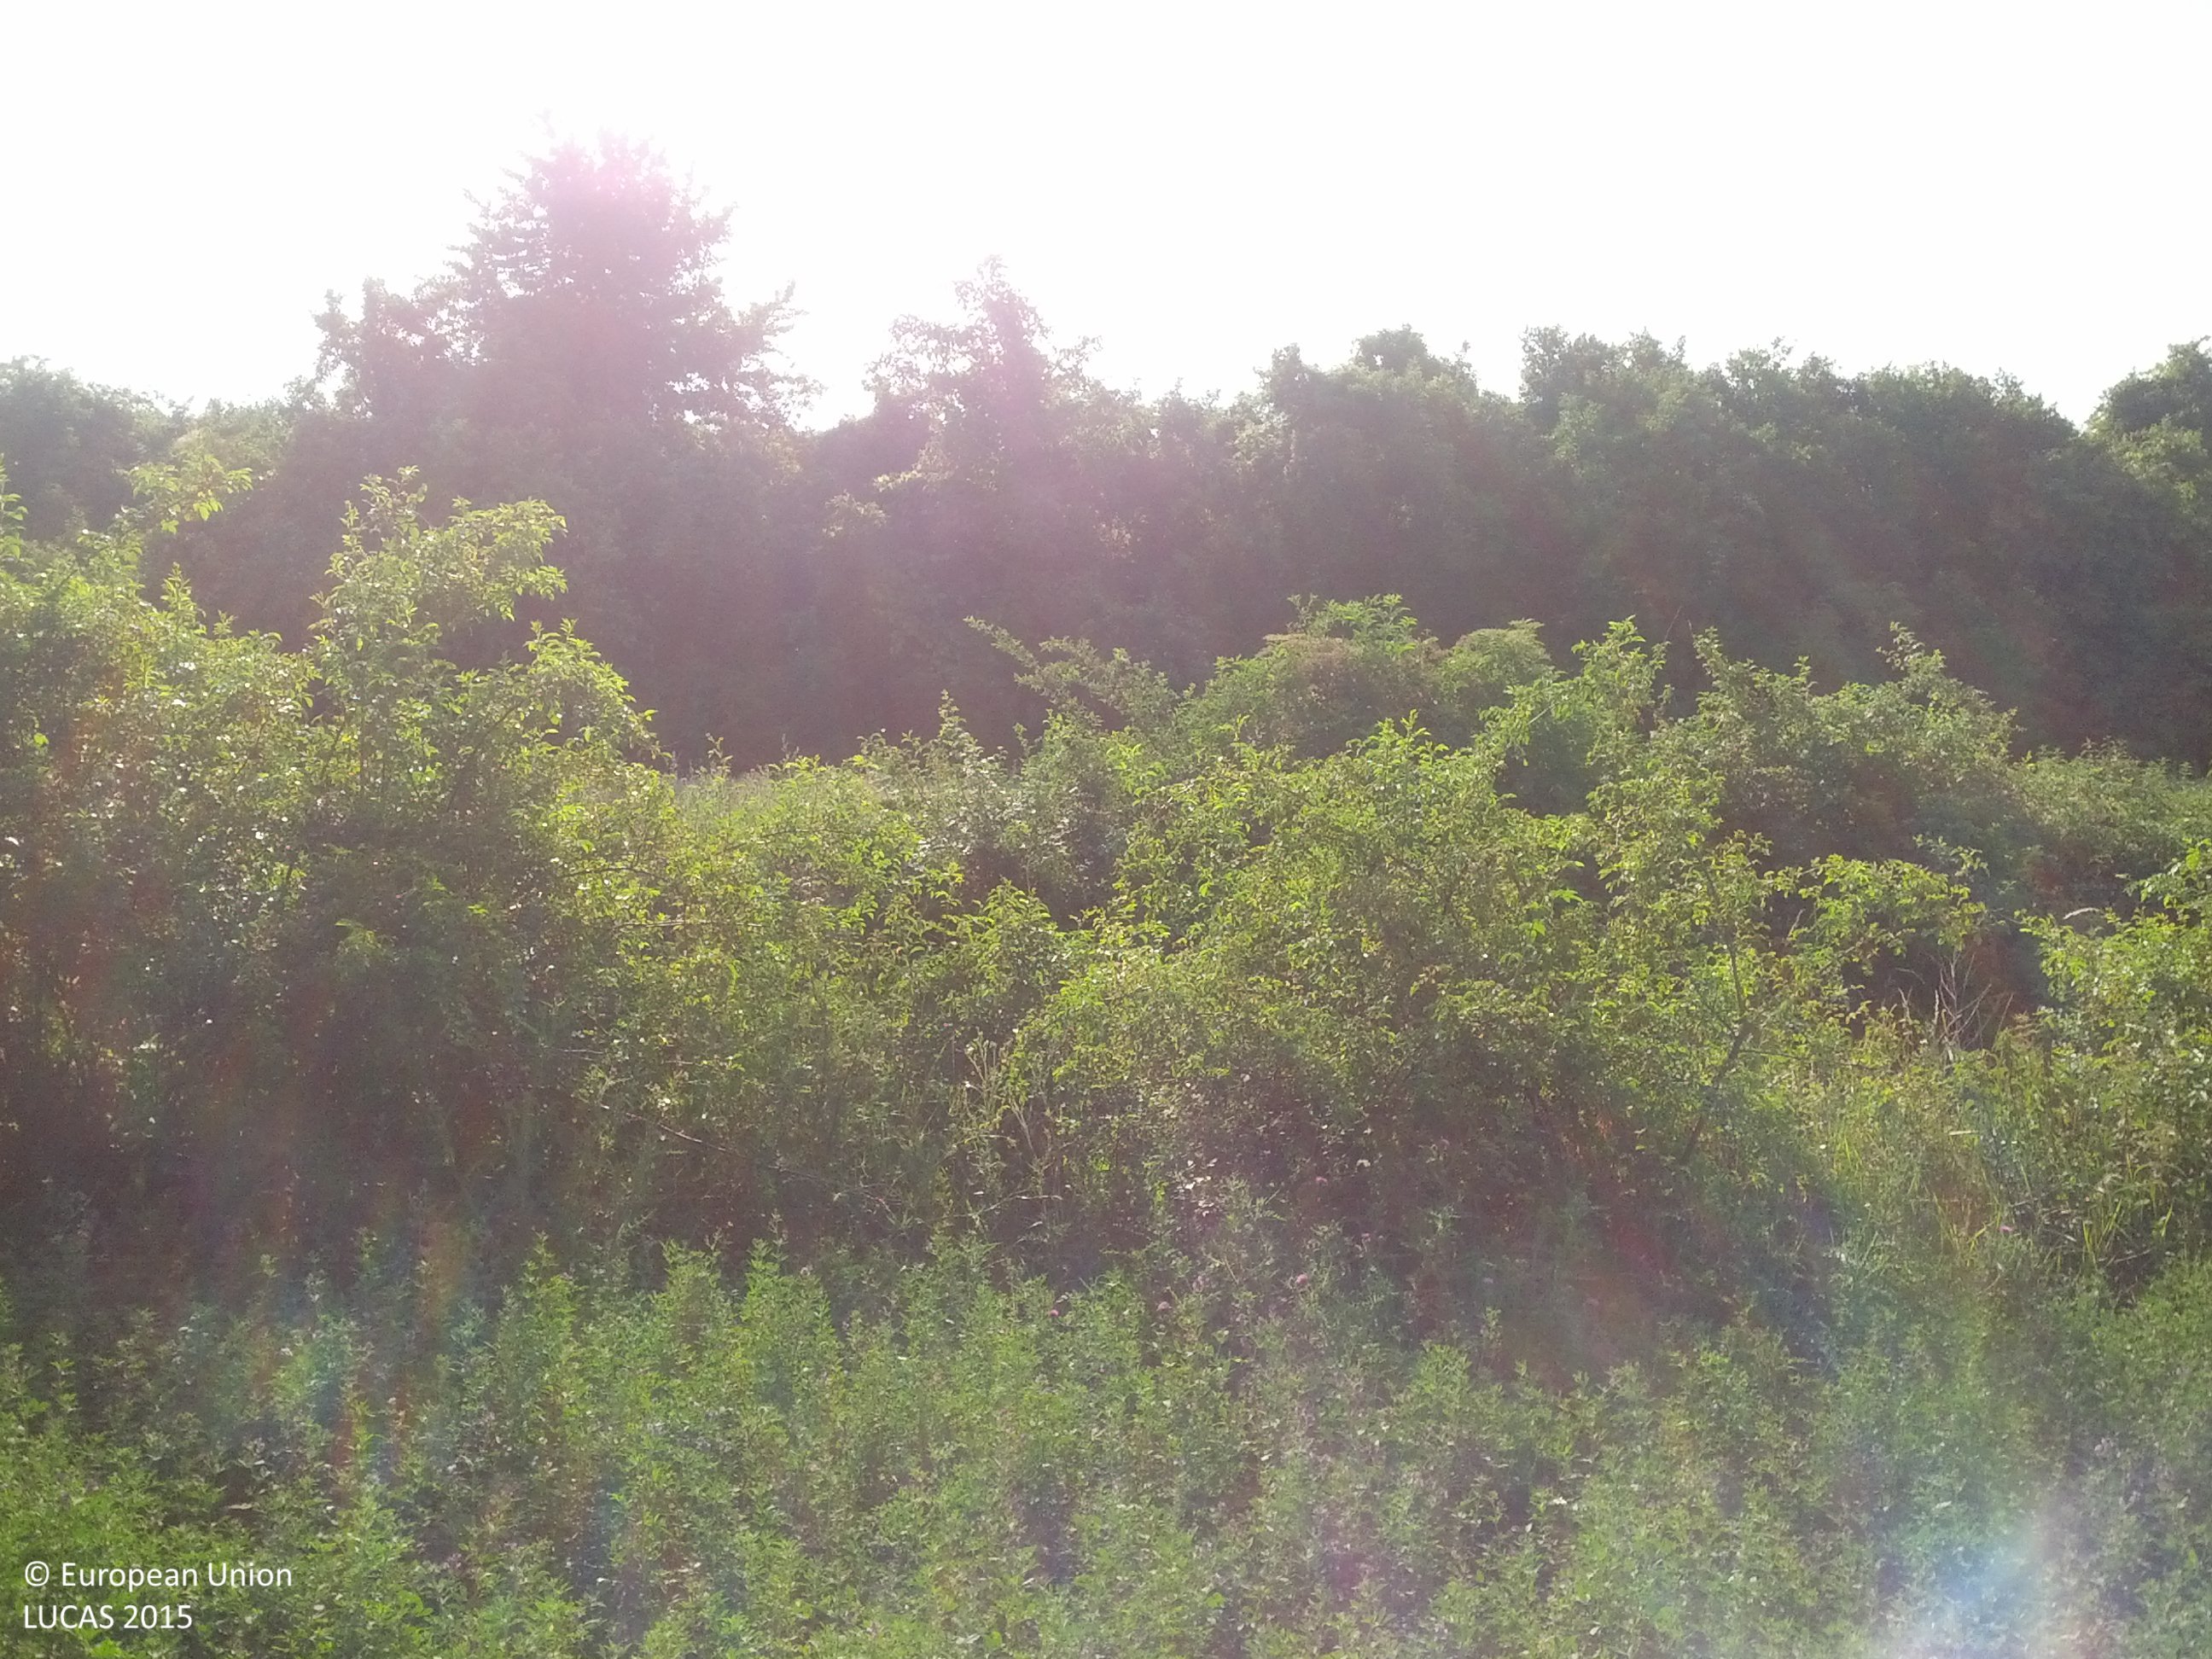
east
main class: Cropland
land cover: Lucerne
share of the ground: > 75 %
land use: Agriculture (excluding fallow land and kitchen gardens)
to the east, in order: Lucerne; Abandoned hedges; Tracks; Grass margins; Abandoned hedges; Oats; Broadleaved woodland; Vineyards; Abandoned hedges; Tracks; Vineyards; Abandoned hedges; Vineyards; Tracks; Grassland without tree/shrub cover; Vineyards
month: June
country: AT
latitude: 48.6744
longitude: 16.6204
